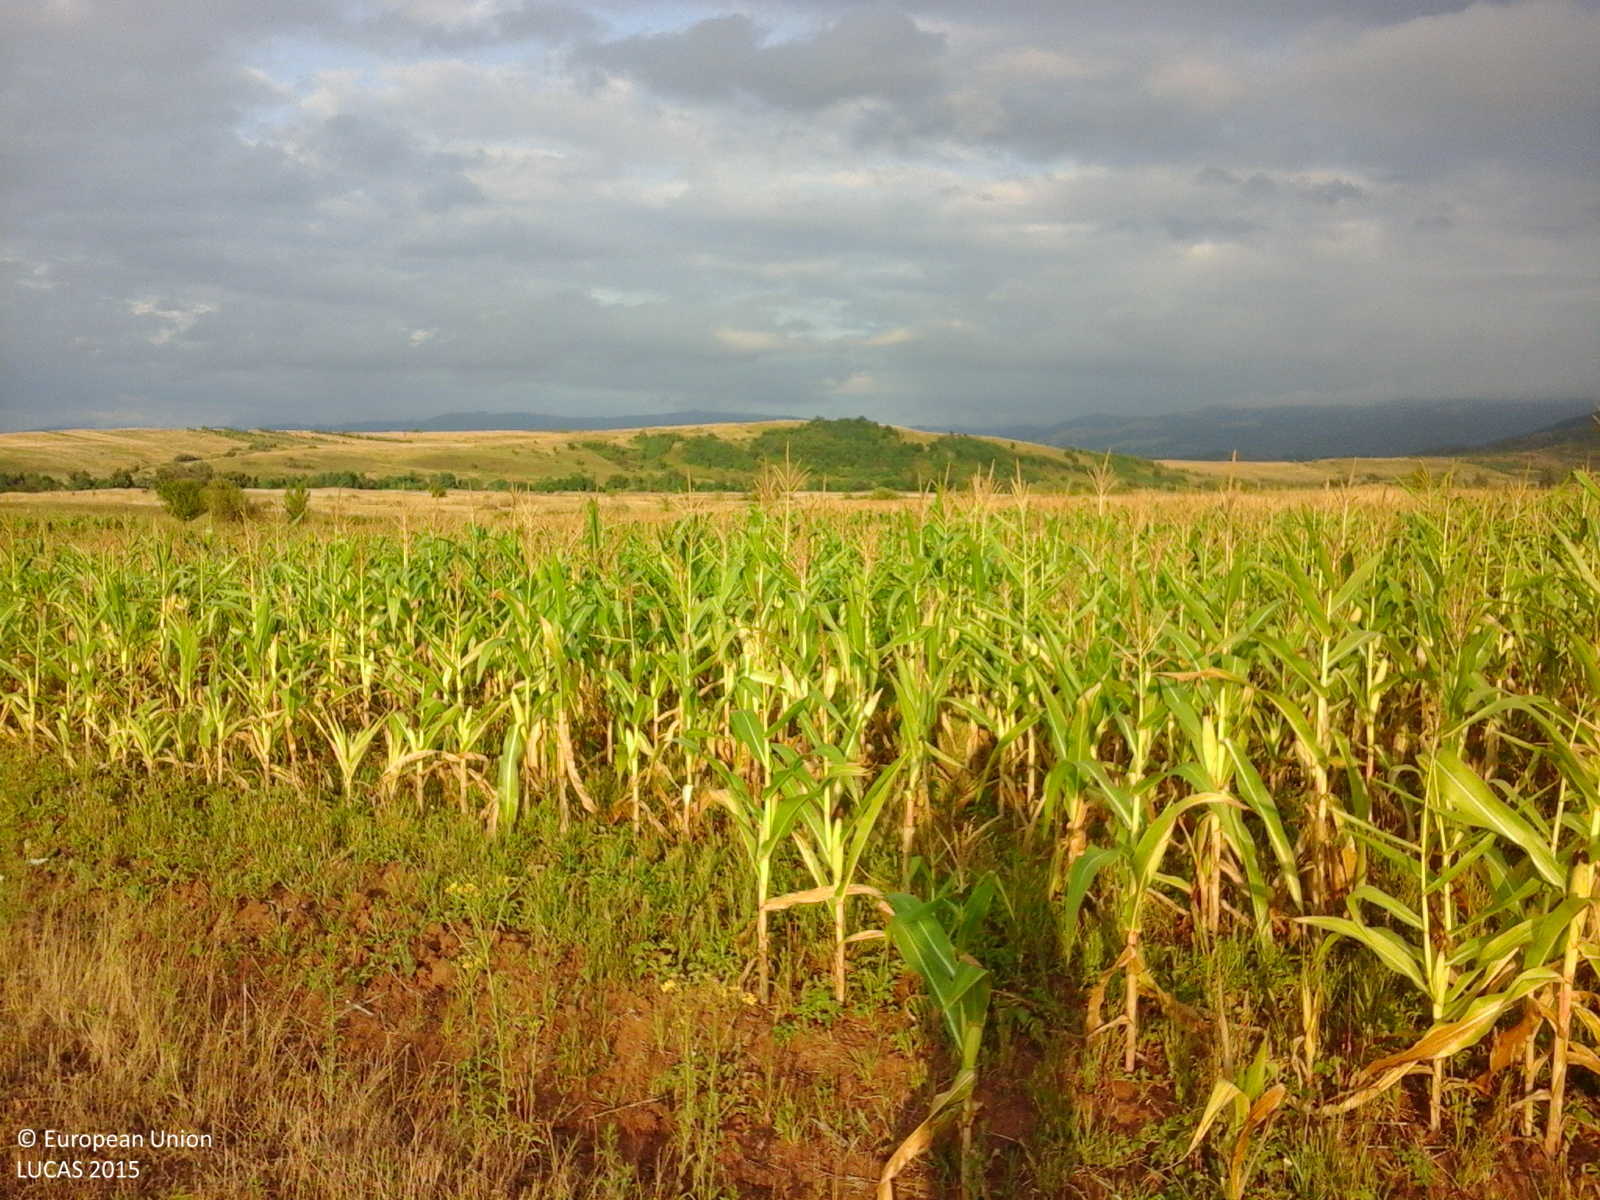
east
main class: Grassland
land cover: Grassland without tree/shrub cover
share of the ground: > 75 %
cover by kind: herbaceous plants 100 %
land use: Agriculture (excluding fallow land and kitchen gardens)
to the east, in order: Grassland without tree/shrub cover; Maize; Spontaneously vegetated surfaces; Tracks; Grassland without tree/shrub cover; Ditches and canals; Grassland without tree/shrub cover; Tracks; Grassland without tree/shrub cover
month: August
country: RO
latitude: 44.8752
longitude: 21.9709
